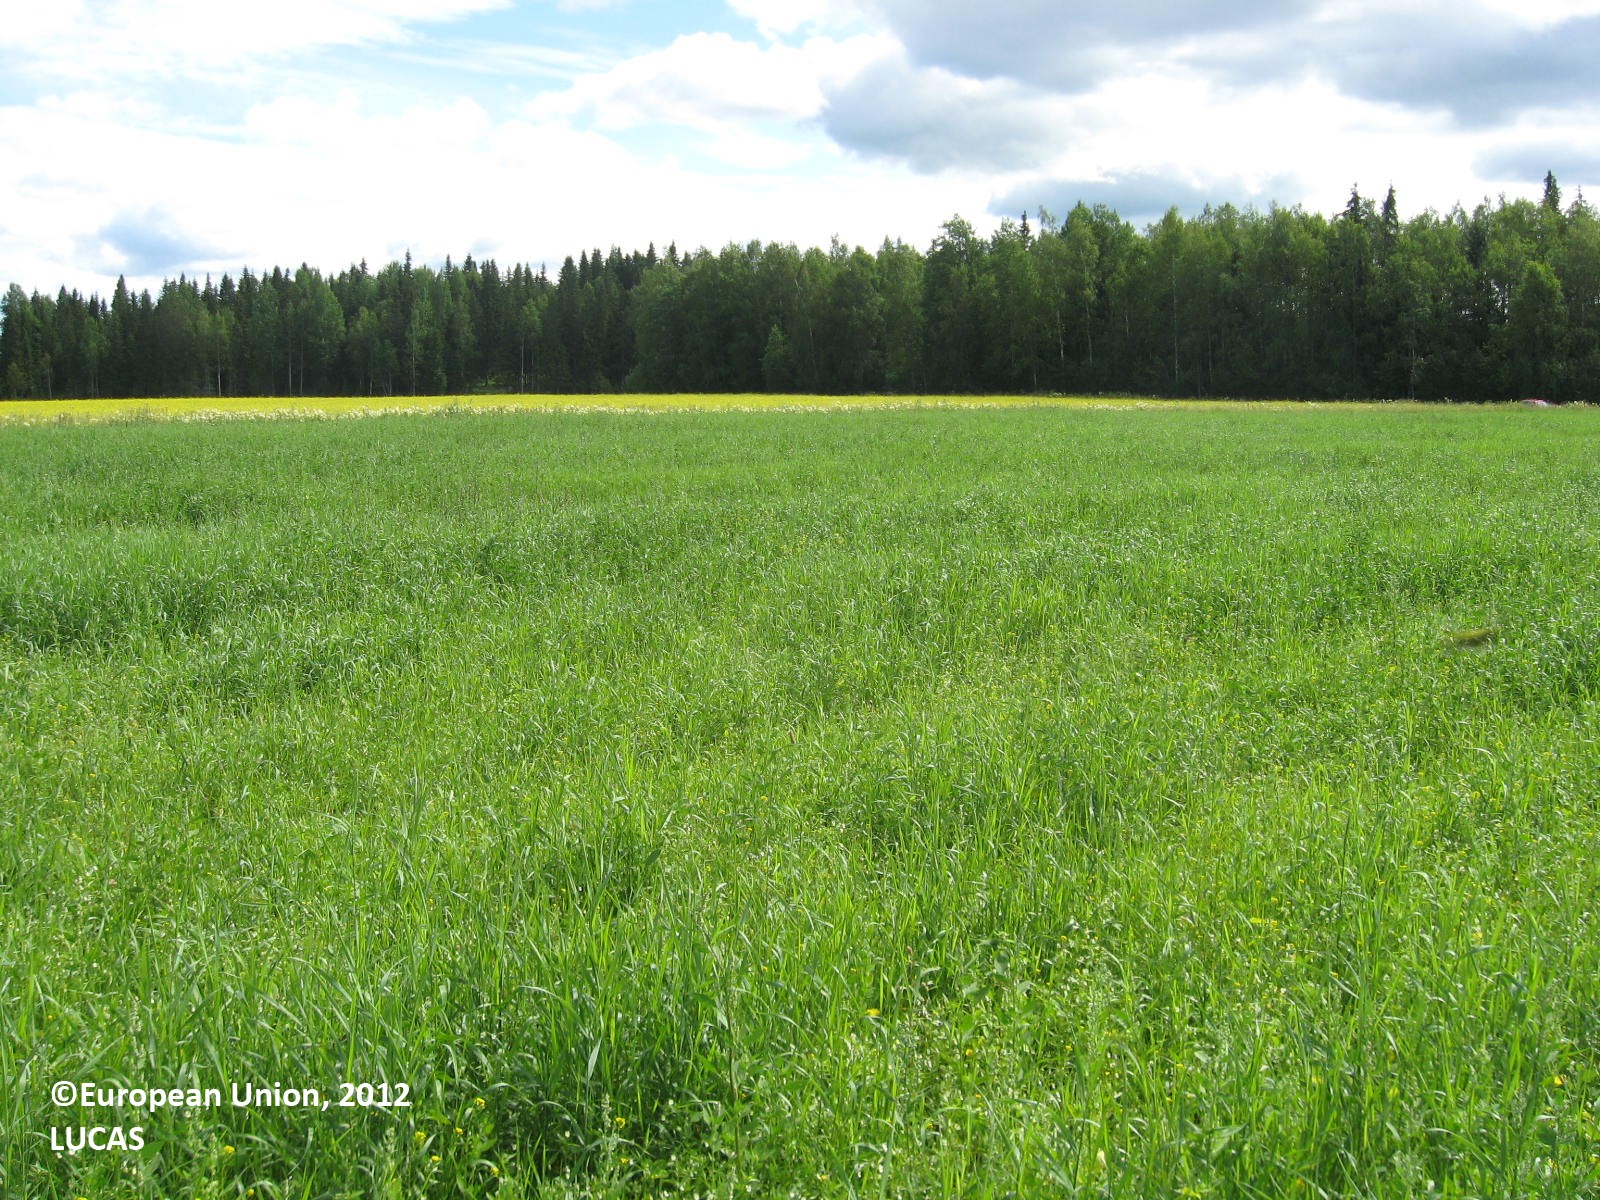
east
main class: Cropland
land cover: Temporary grasslands
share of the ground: > 75 %
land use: Agriculture (excluding fallow land and kitchen gardens)
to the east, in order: Temporary grasslands; Shruby margins; Ditches and canals; Shruby margins; Rape and turnip rape; Shruby margins; Grass margins; Tracks; Grass margins; Ditches and canals; Grass margins; Mixed cereals for fodder
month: July
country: FI
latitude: 62.3145
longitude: 21.5242
